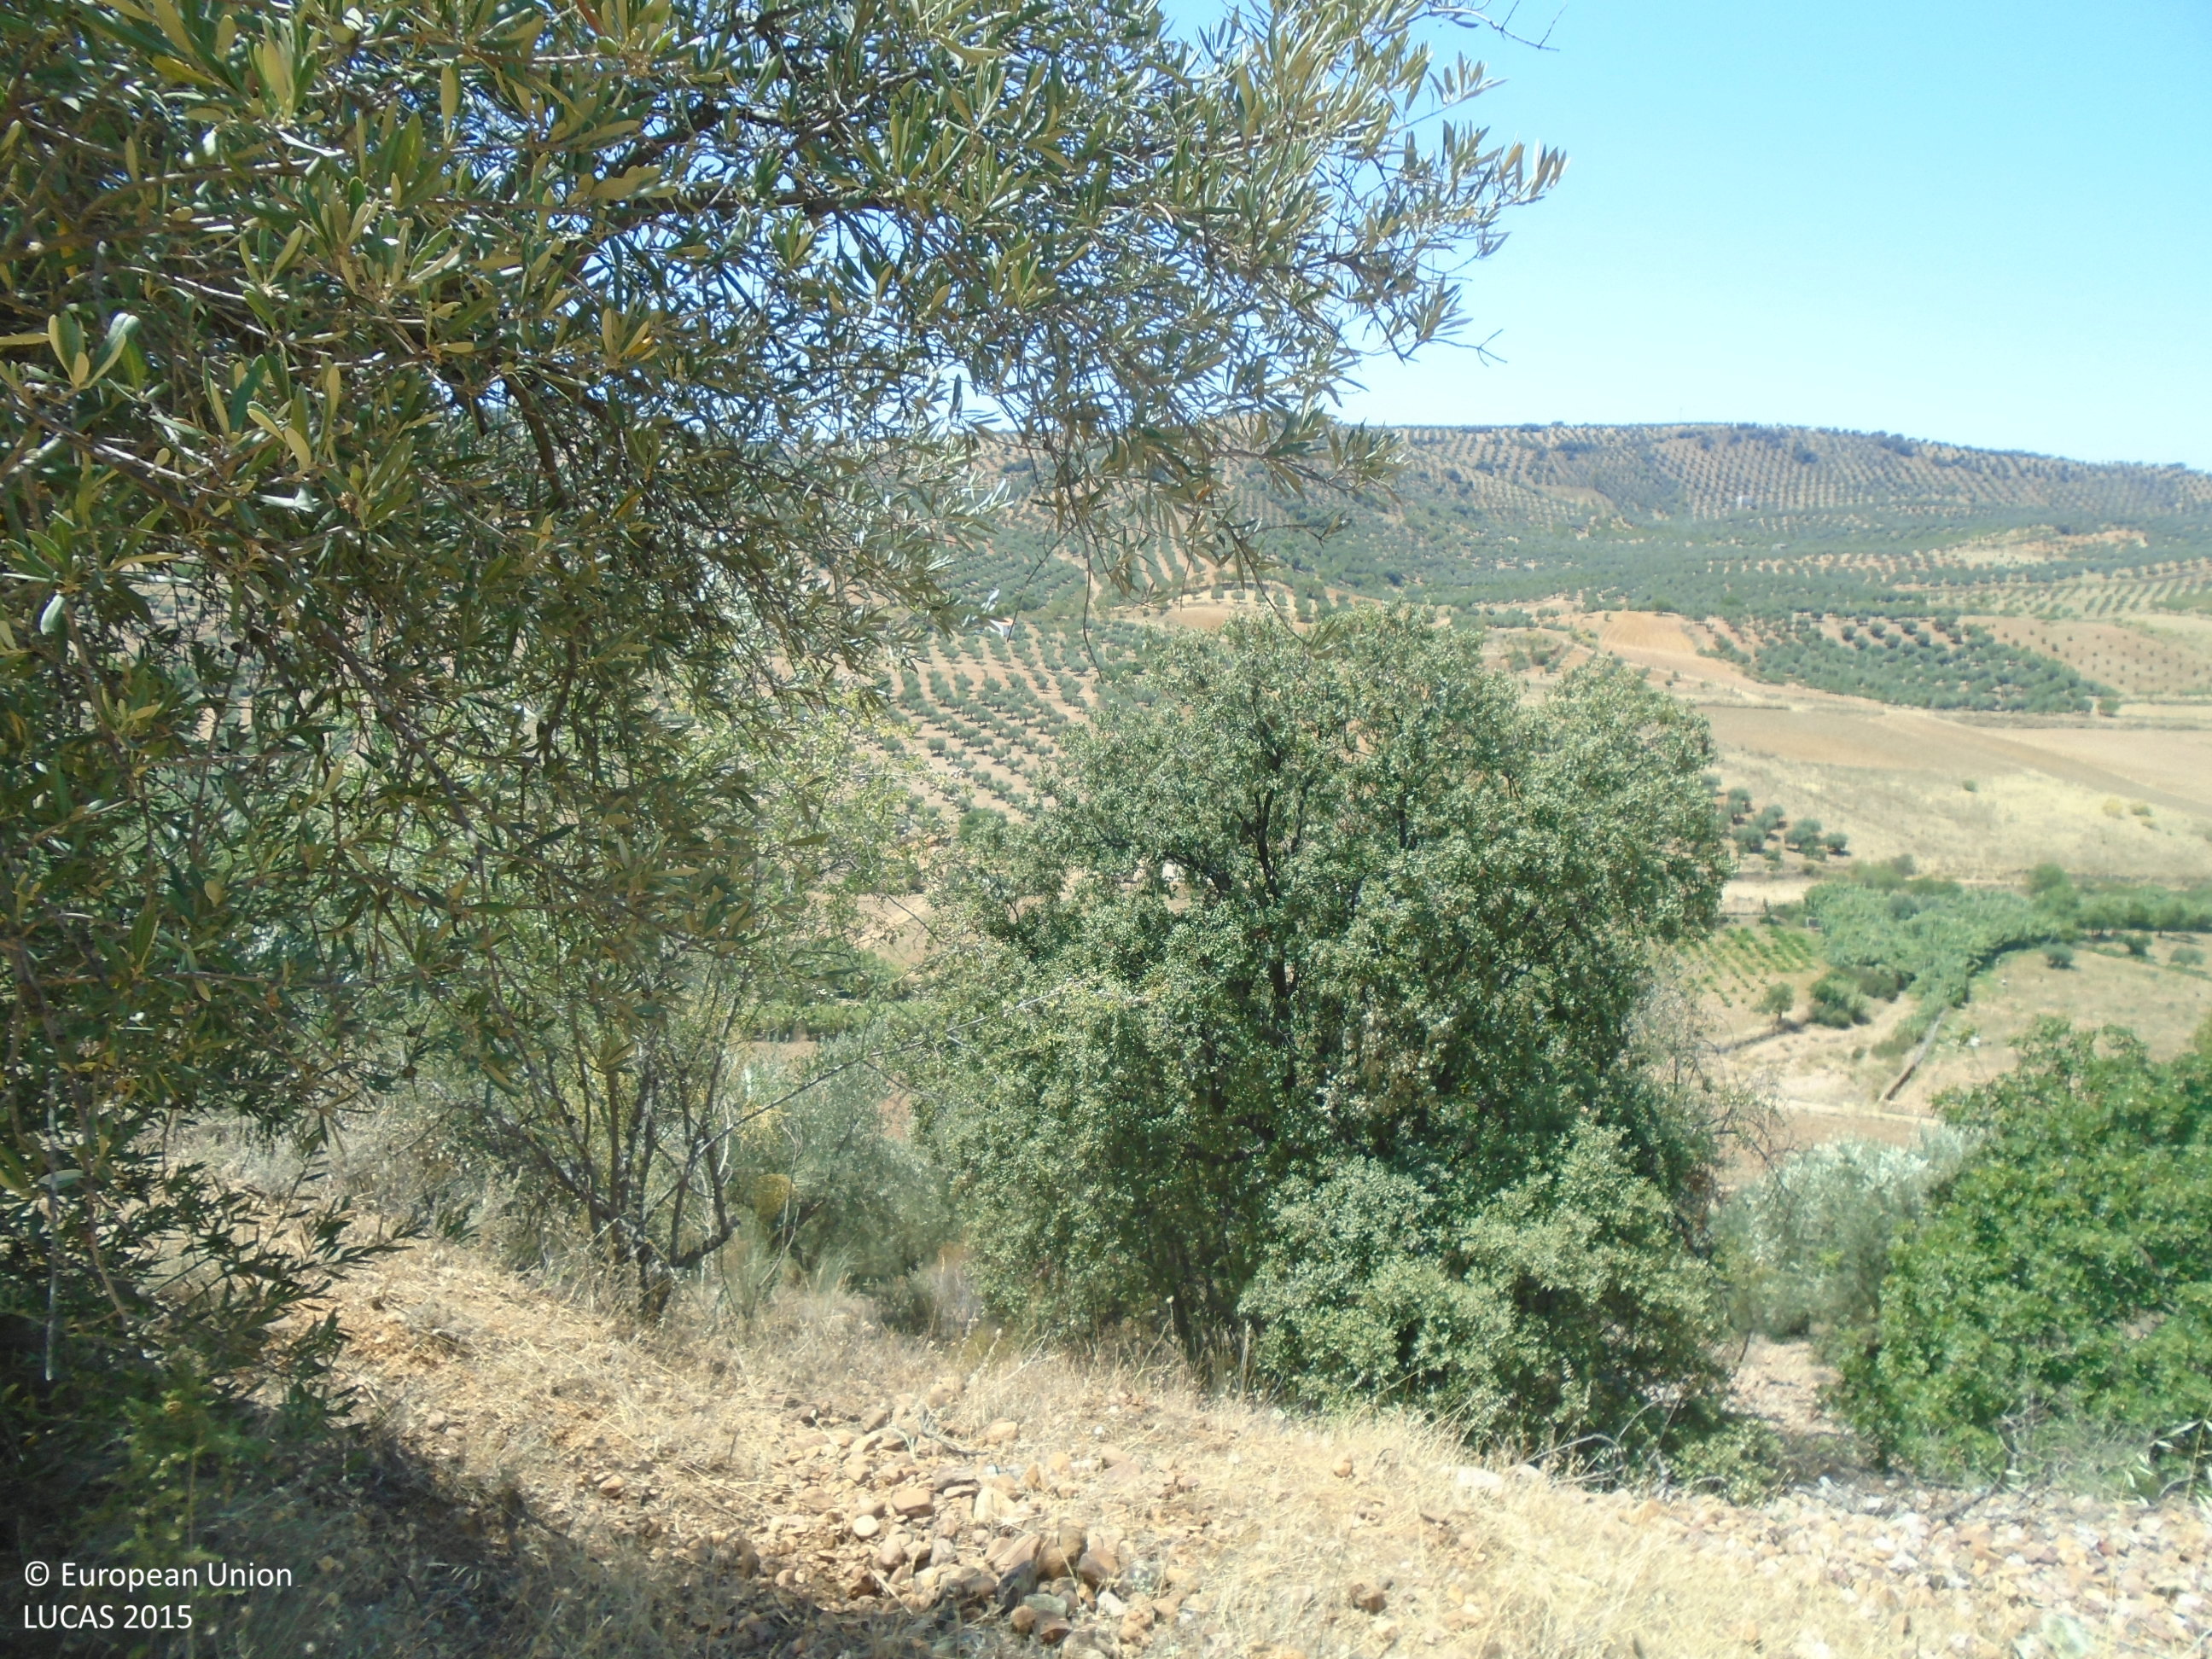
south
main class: Cropland
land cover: Olive groves
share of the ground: 10 - 25 %
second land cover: Spontaneously vegetated surfaces
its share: > 75 %
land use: Agriculture (excluding fallow land and kitchen gardens)
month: July
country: ES
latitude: 39.7394
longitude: -4.9477
